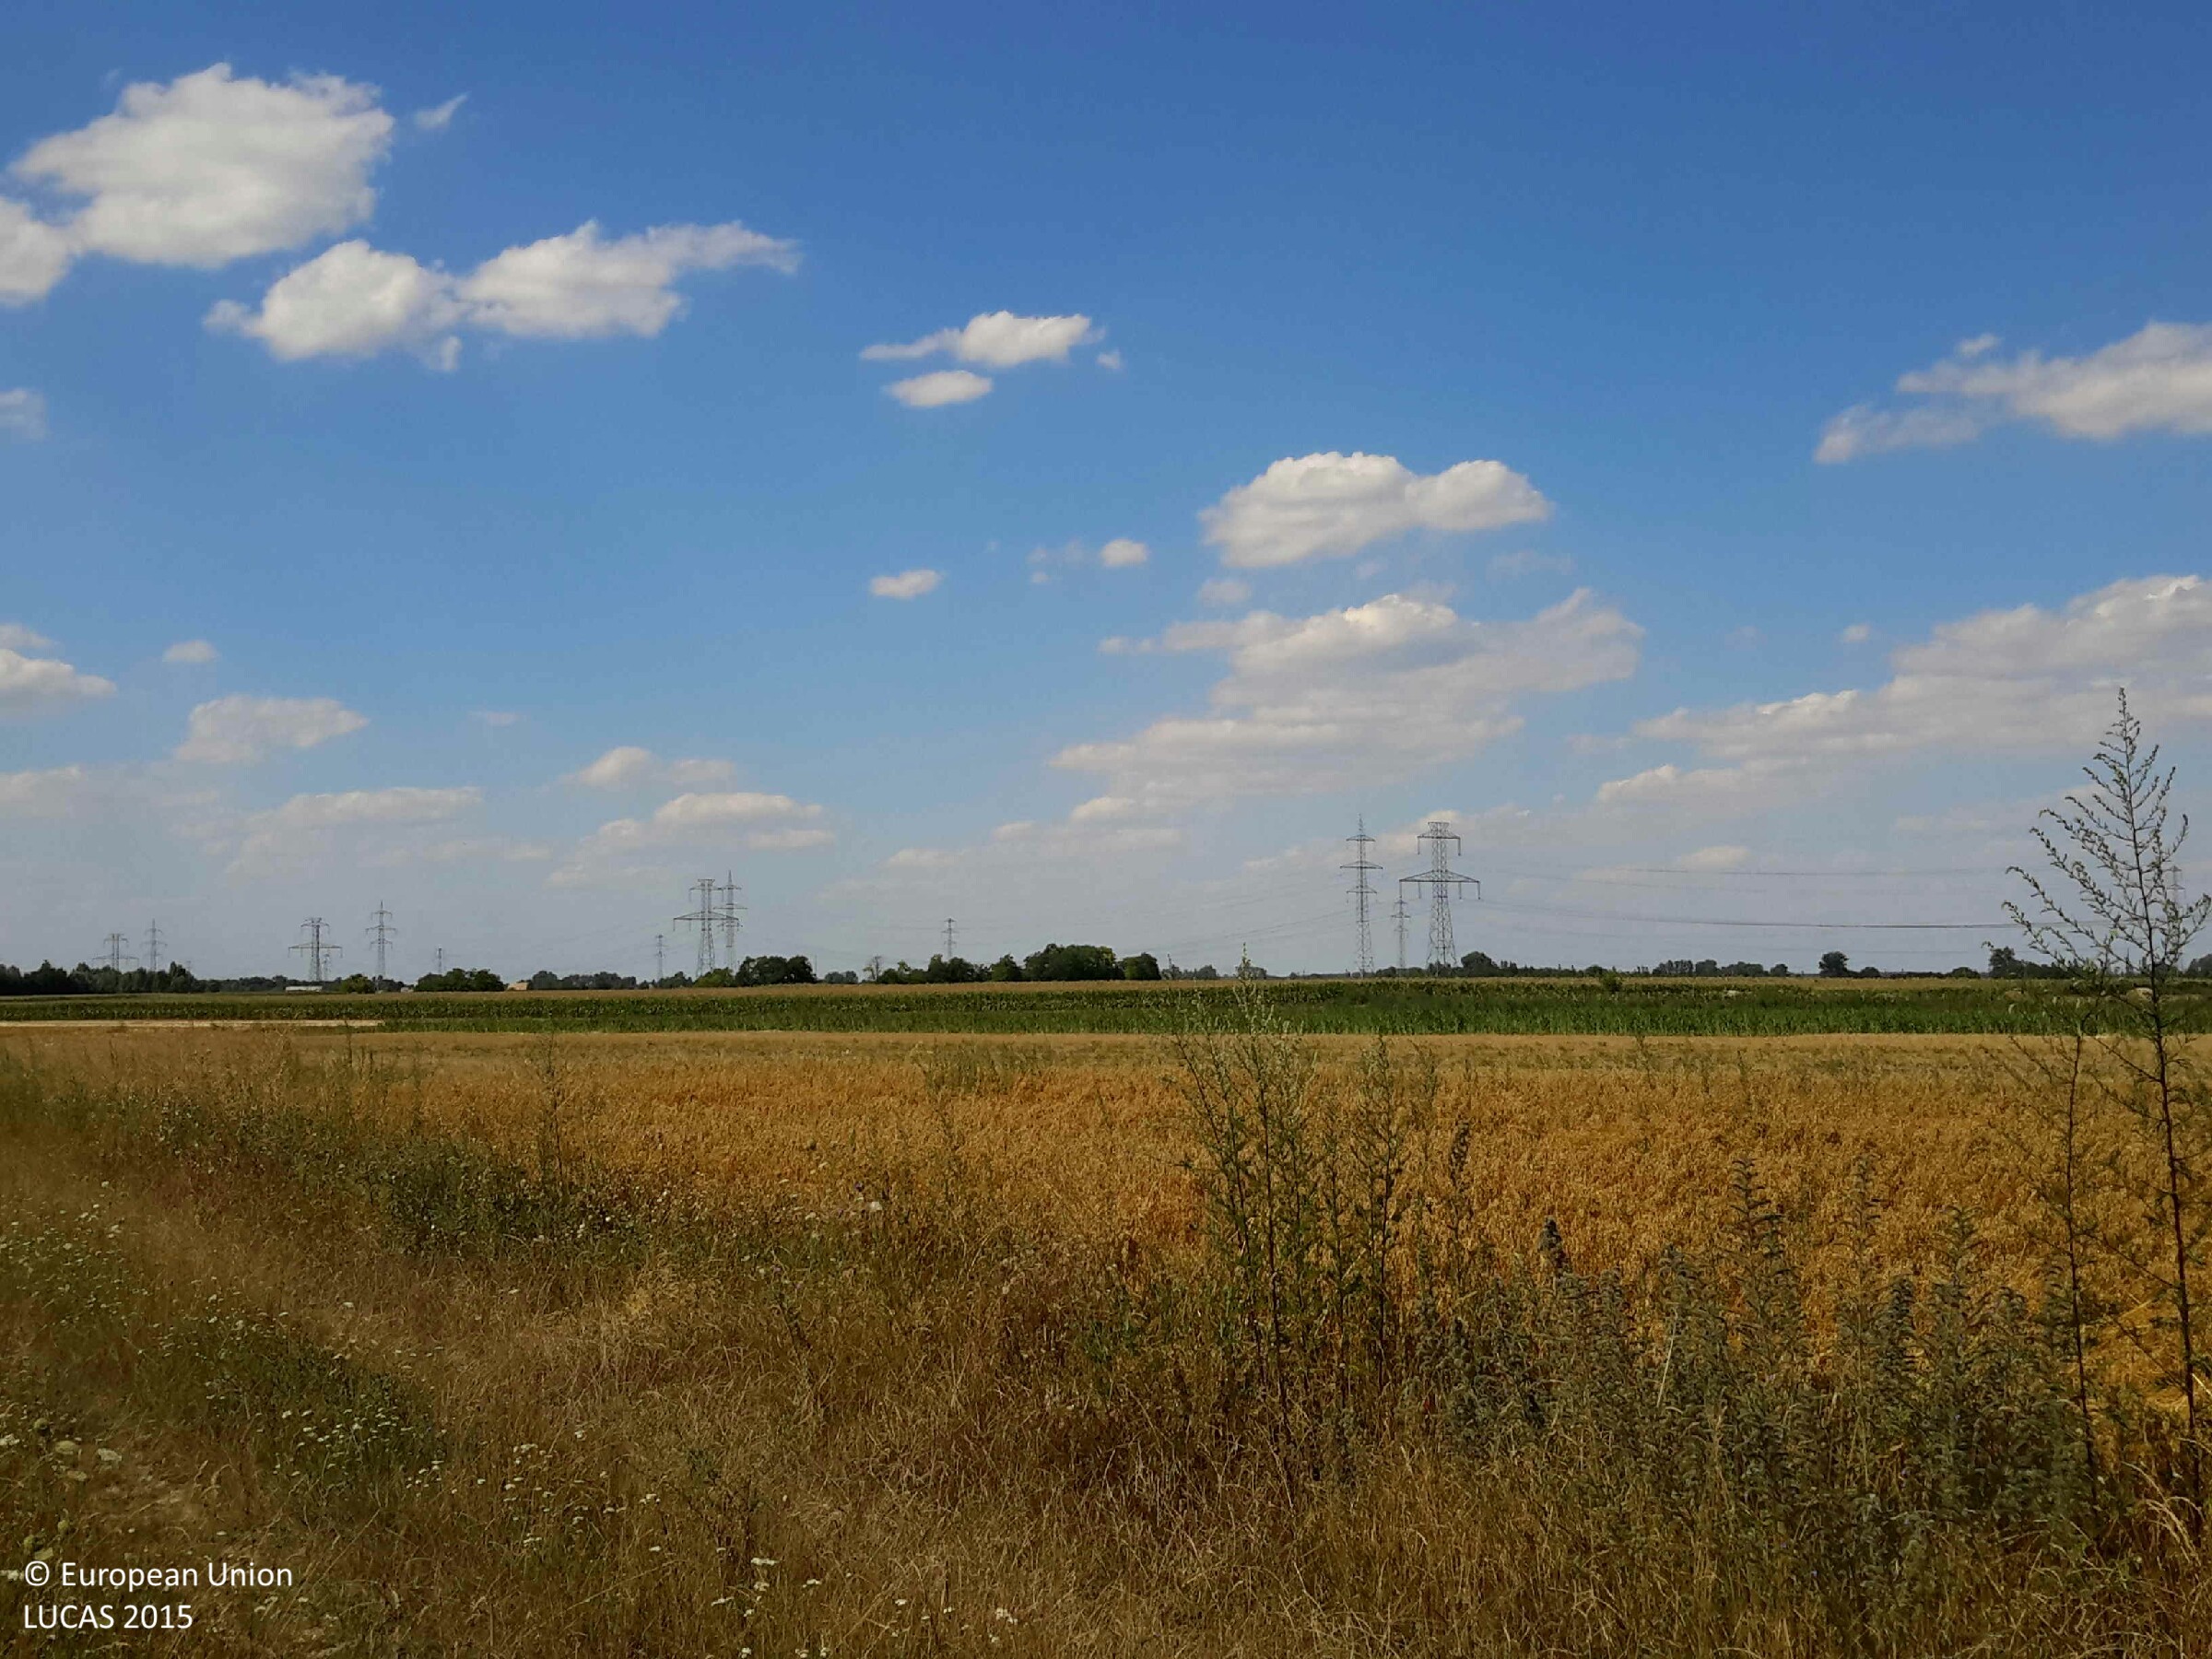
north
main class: Grassland
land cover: Grassland without tree/shrub cover
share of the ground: > 75 %
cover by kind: herbaceous plants 95 %, shrubs 5 %
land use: Agriculture (excluding fallow land and kitchen gardens)
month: July
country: HU
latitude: 47.7373
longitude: 17.4361
